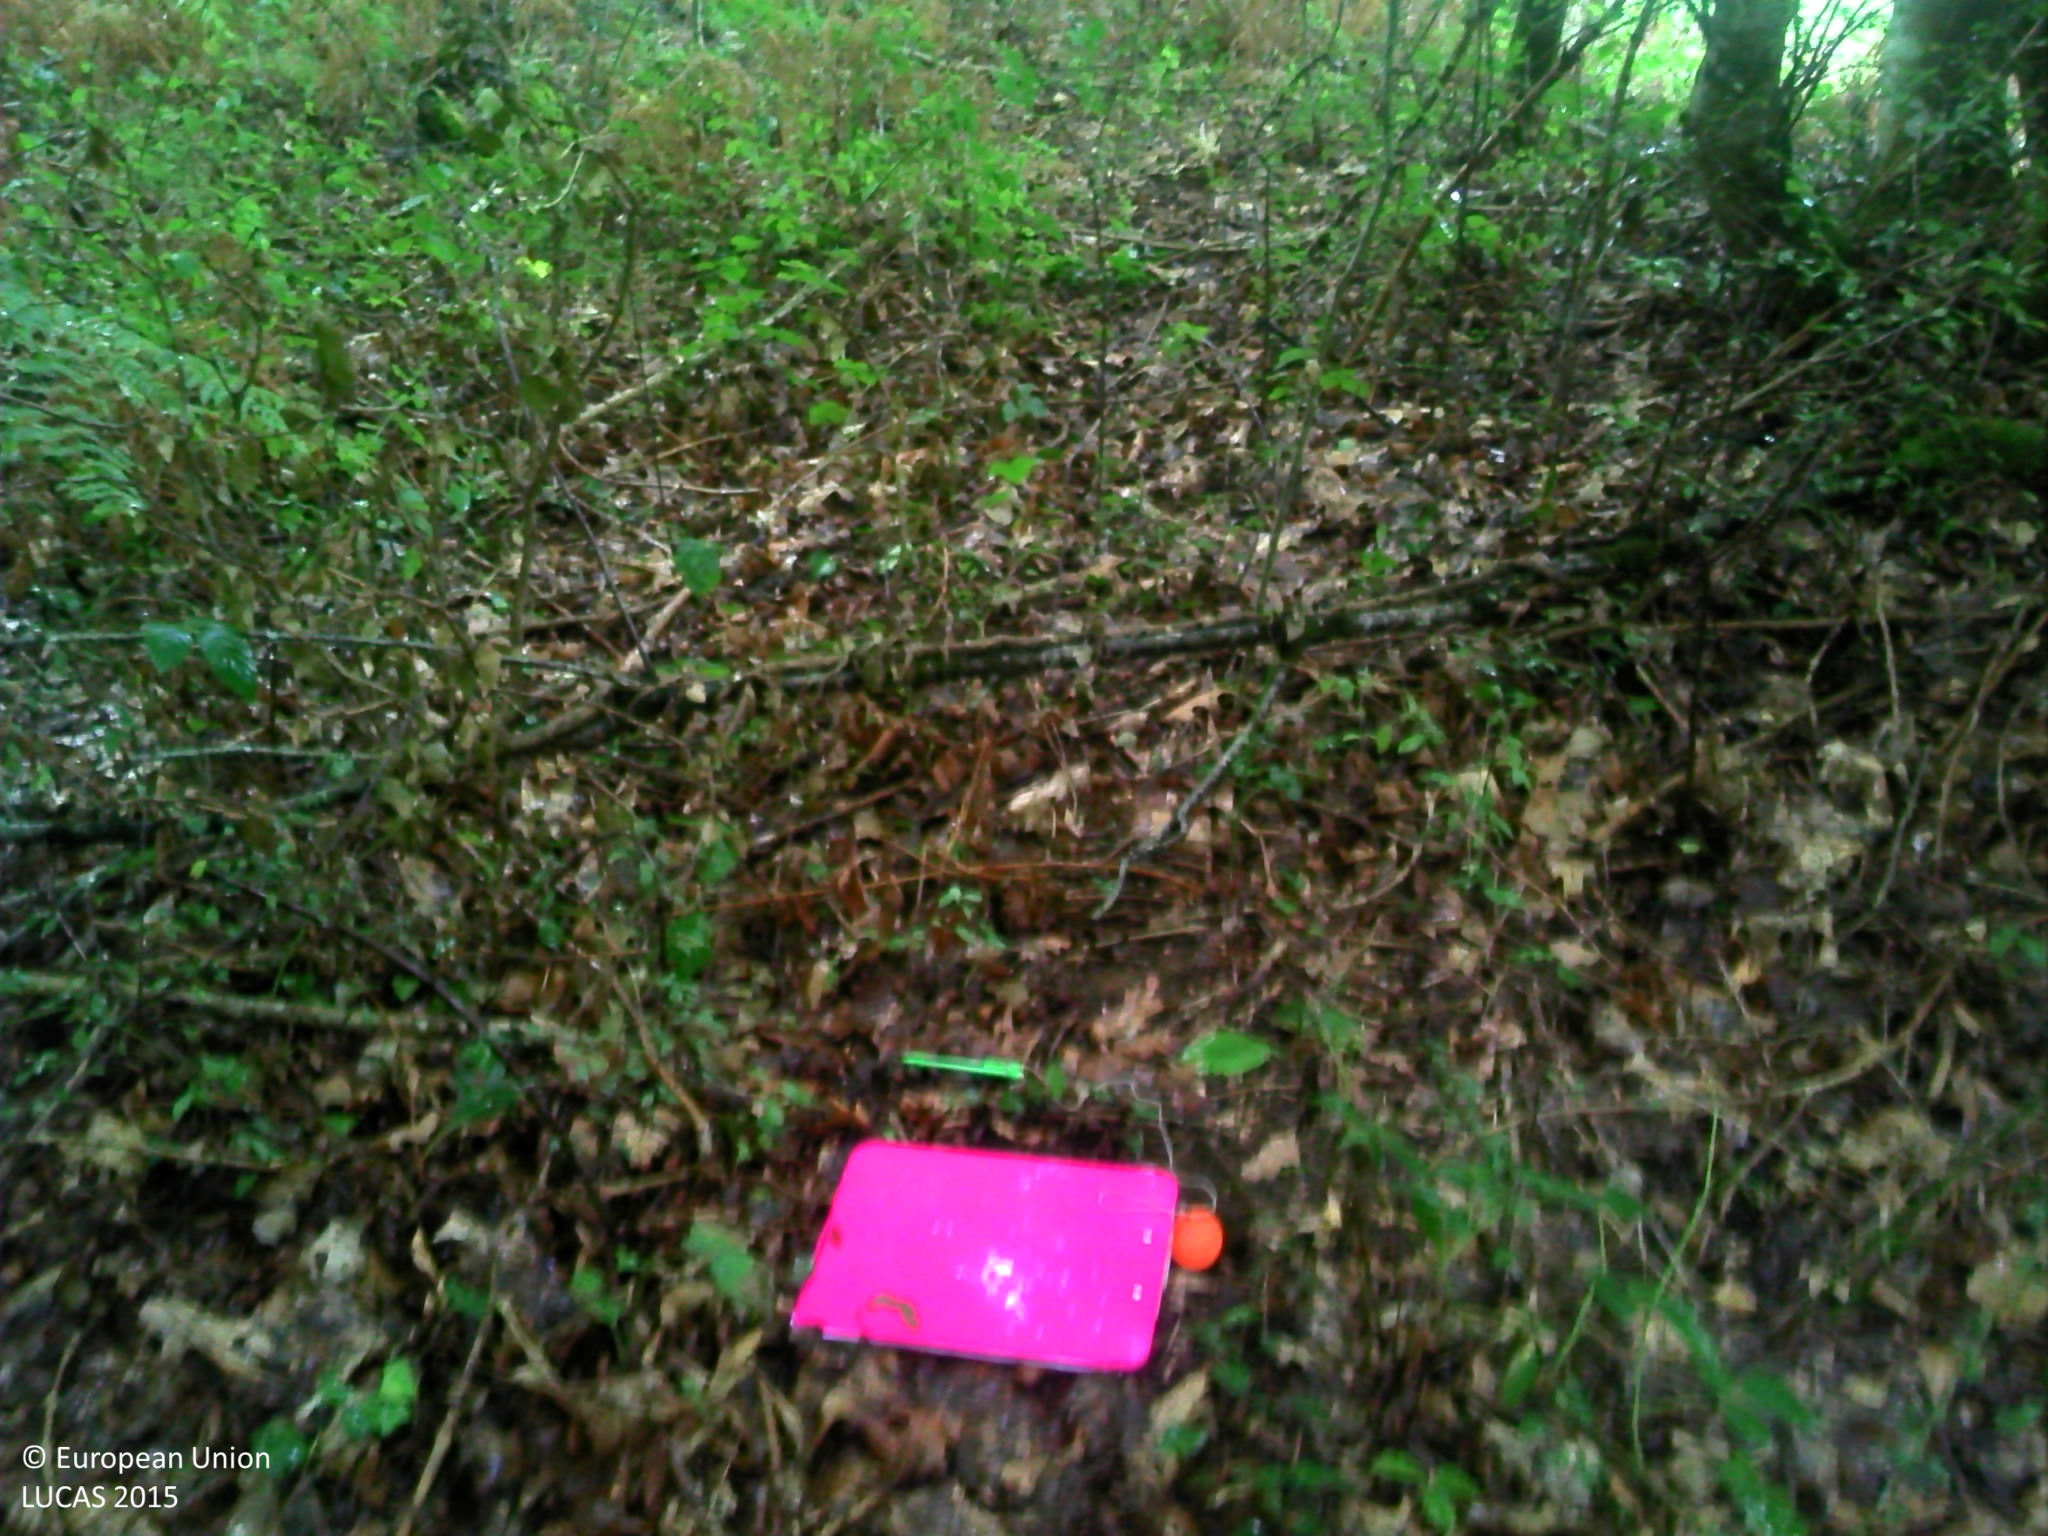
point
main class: Woodland
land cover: Broadleaved woodland
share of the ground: > 75 %
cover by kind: broadleaved forest trees 95 %, coniferous forest trees 5 %
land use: Semi-natural and natural areas not in use
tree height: > 5 m
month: August
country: FR
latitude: 45.9863
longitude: 0.9646
